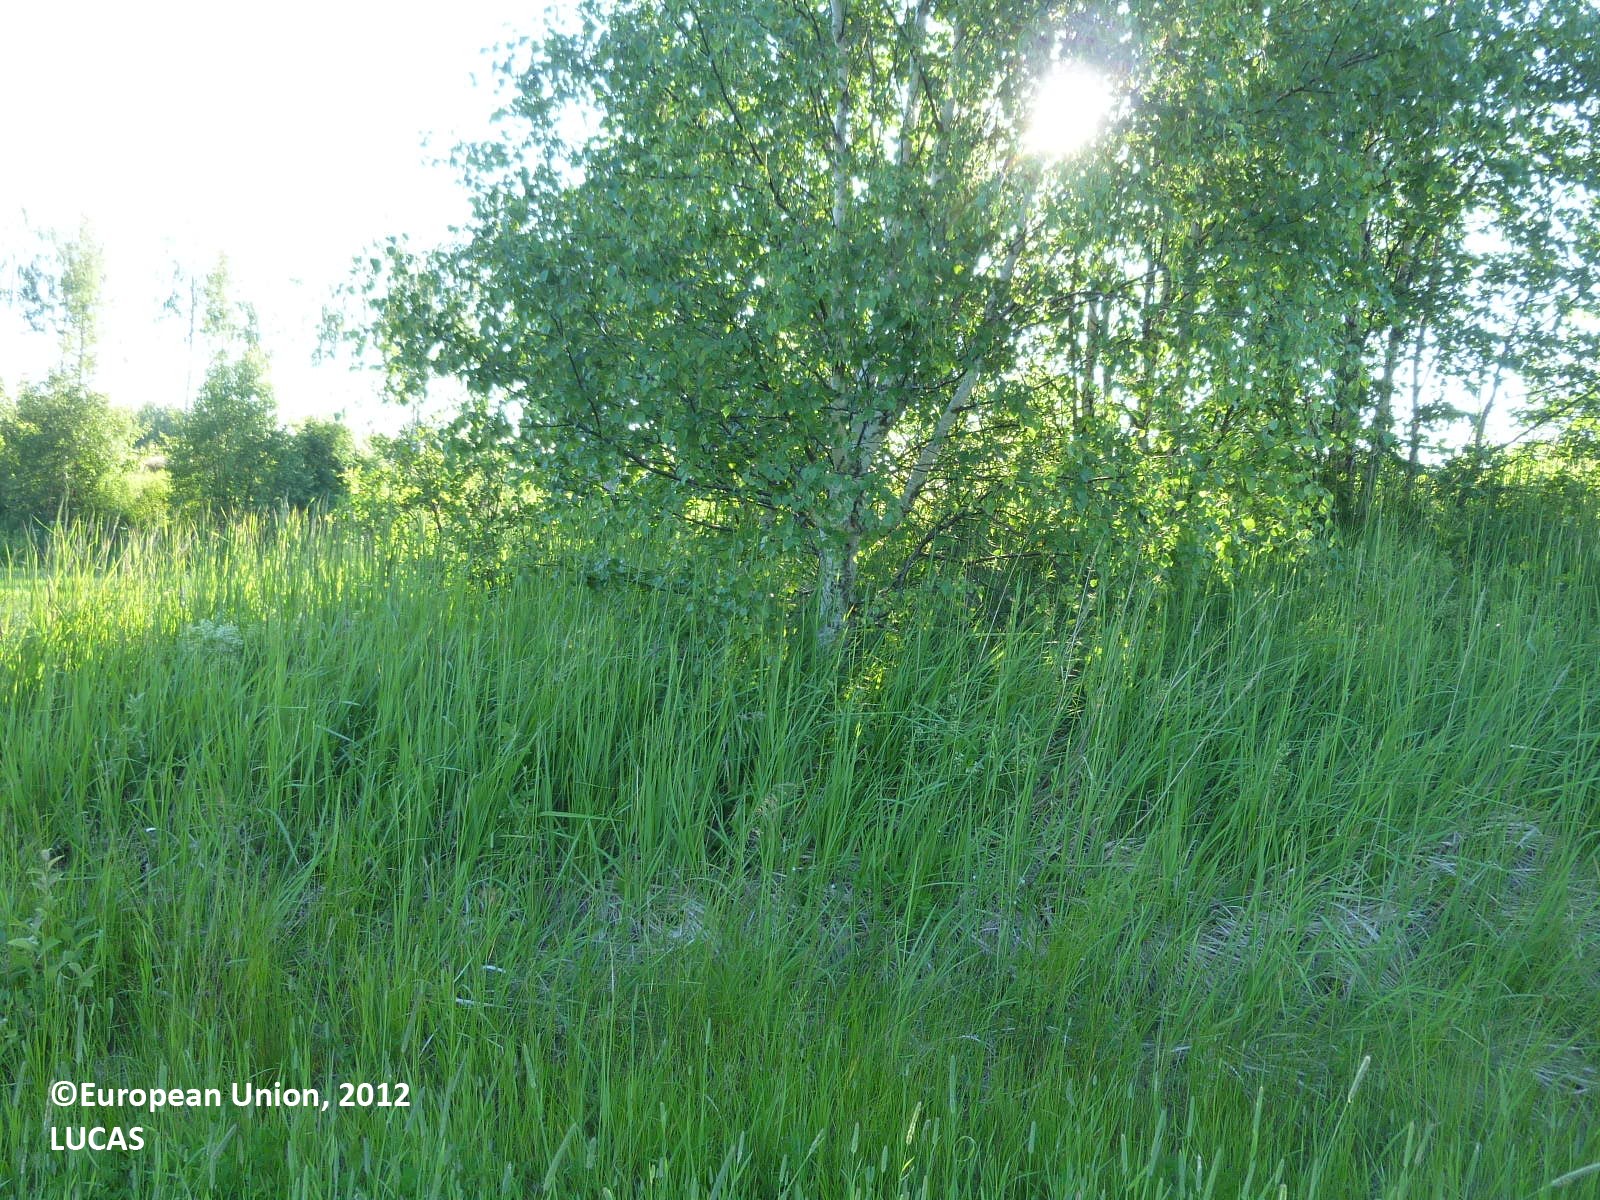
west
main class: Cropland
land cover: Oats
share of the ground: > 75 %
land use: Agriculture (excluding fallow land and kitchen gardens)
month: June
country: FI
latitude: 60.0854
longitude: 22.4215
